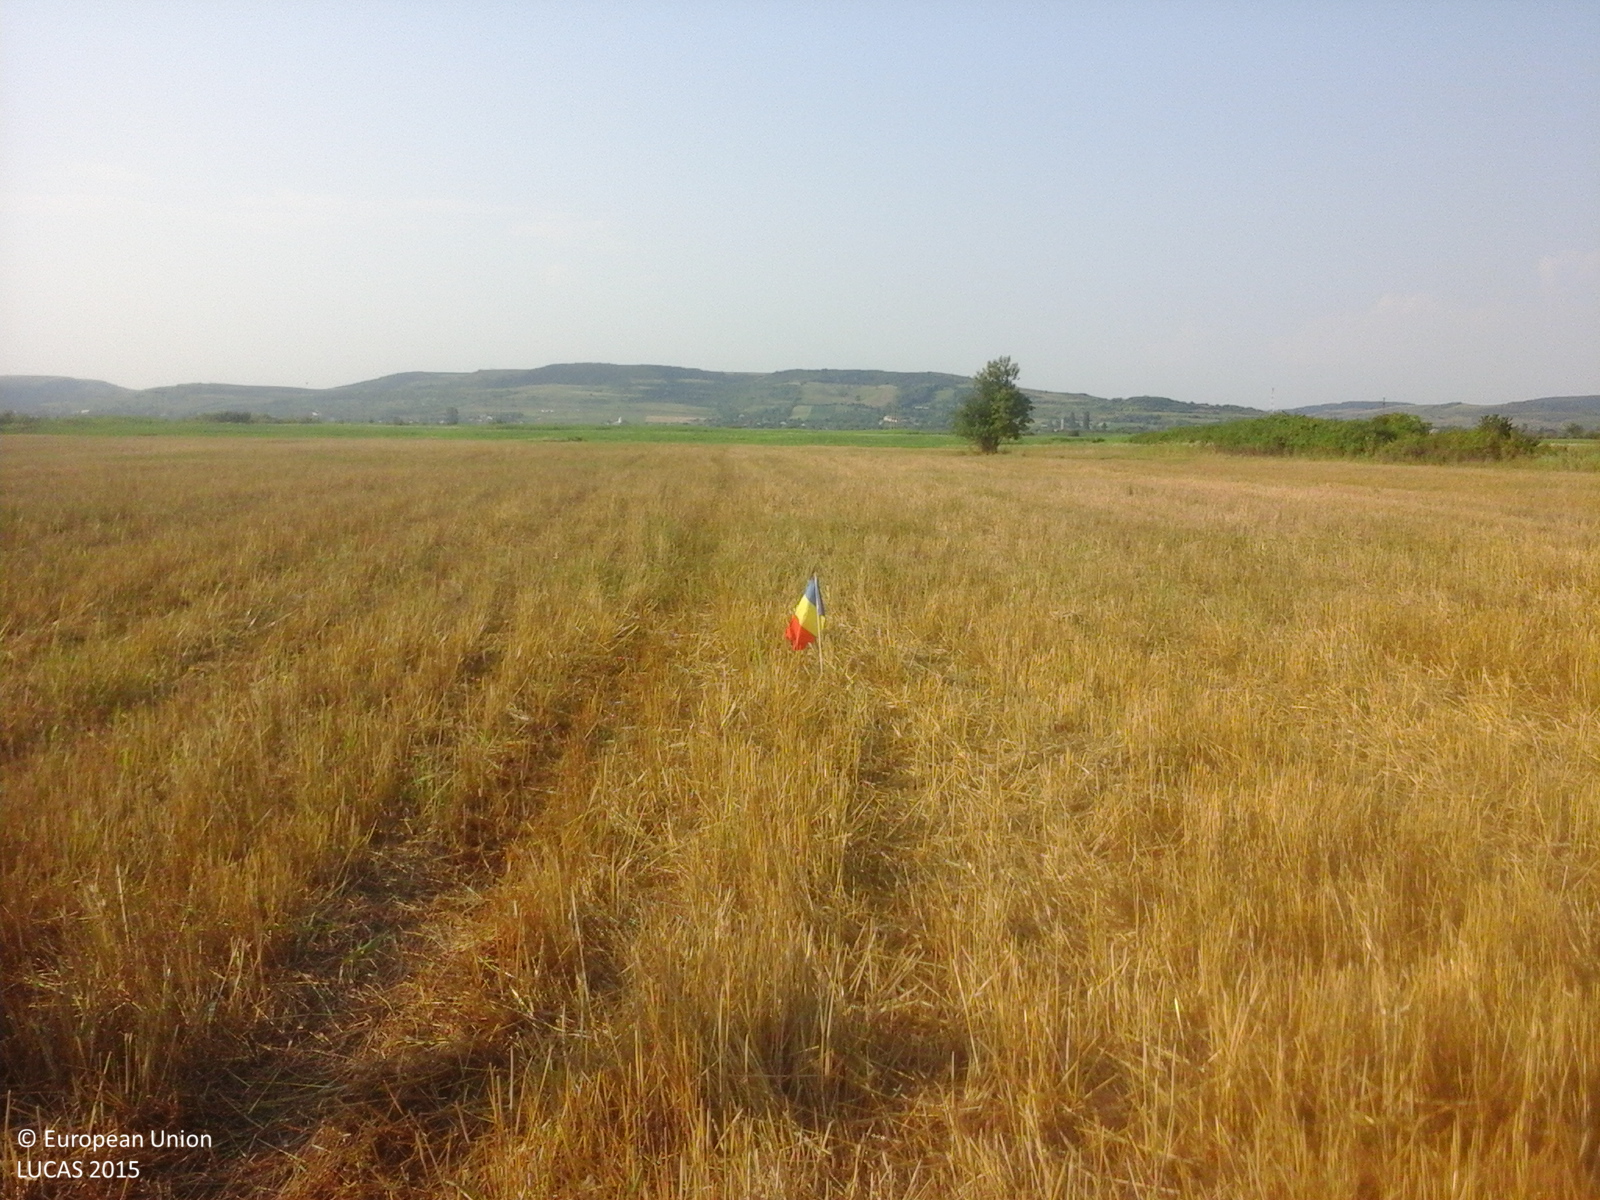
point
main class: Cropland
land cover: Common wheat
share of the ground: < 10 %
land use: Agriculture (excluding fallow land and kitchen gardens)
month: July
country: RO
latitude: 44.8075
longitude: 25.0163
